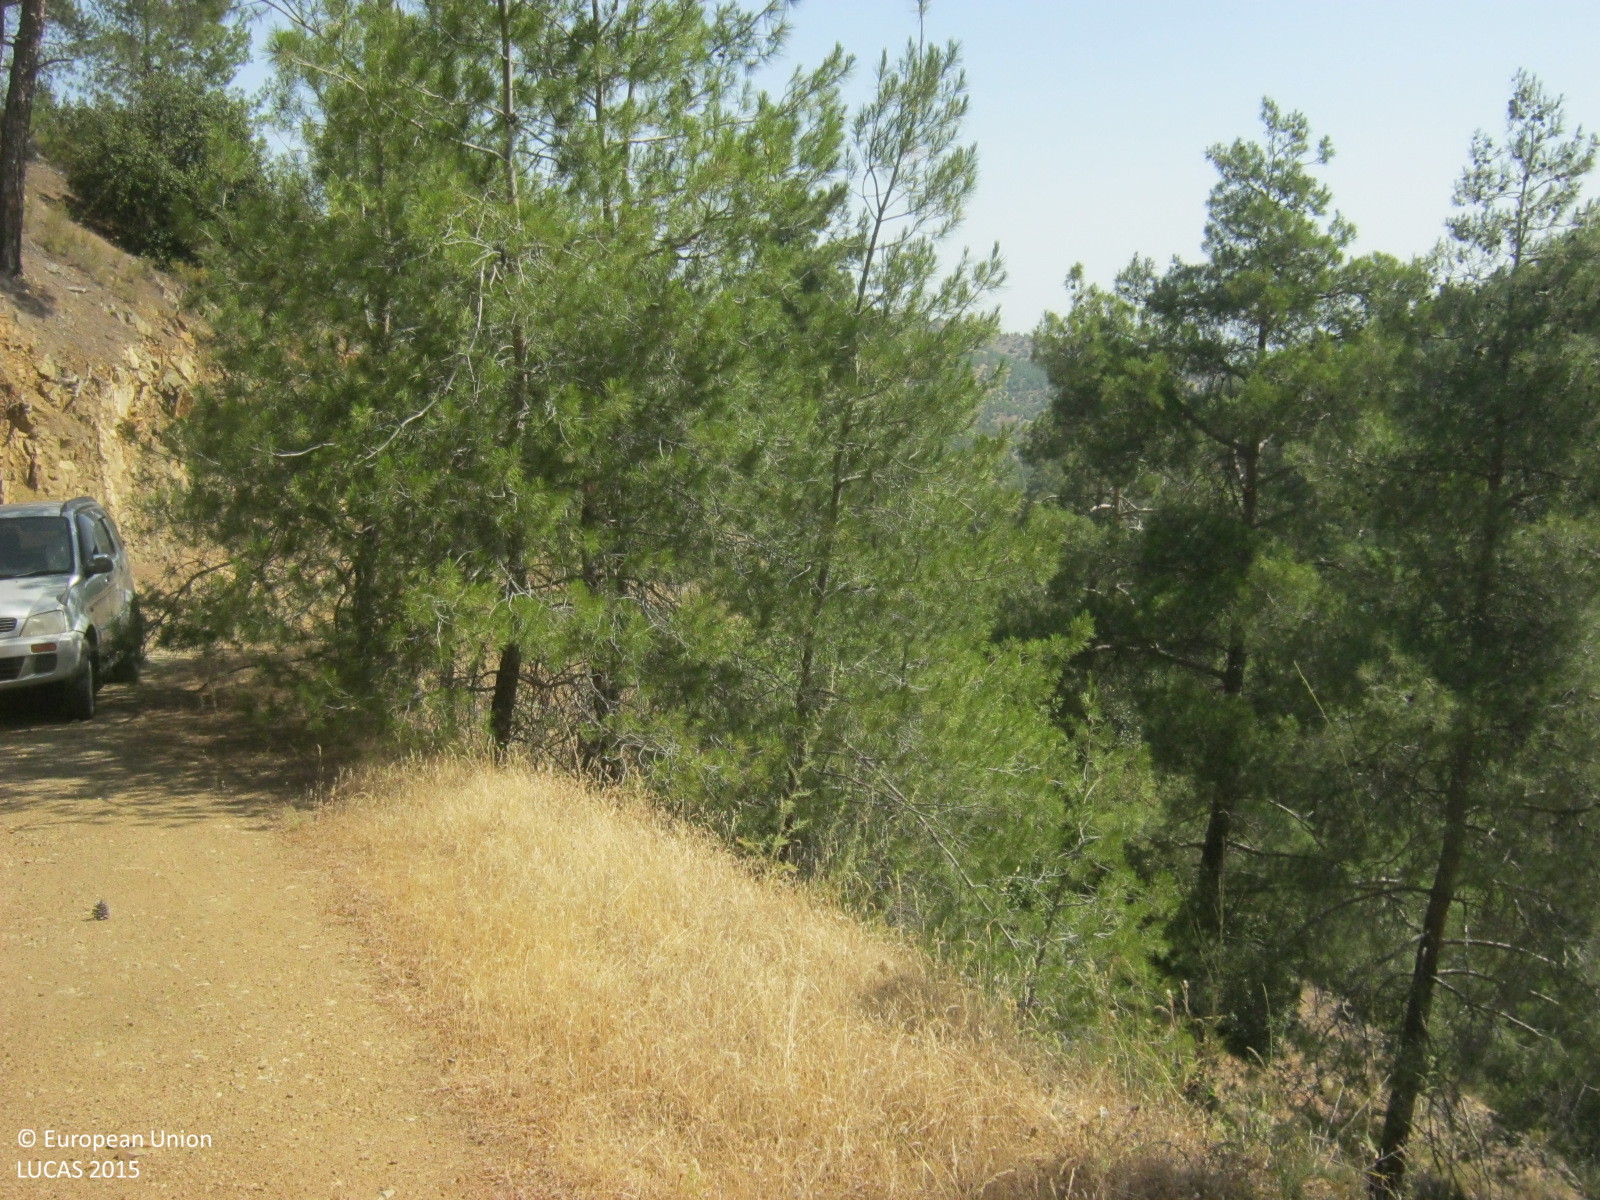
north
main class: Woodland
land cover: Pine dominated mixed woodland
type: coniferous forest of the mediterranean region
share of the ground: 25 - 50 %
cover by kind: coniferous forest trees 40 %, unconsolidated bare surface 20 %, broadleaved forest trees 15 %, shrubs 15 %, herbaceous plants 10 %
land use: Forestry
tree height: > 5 m
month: June
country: CY
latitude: 35.0237
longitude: 32.9815
